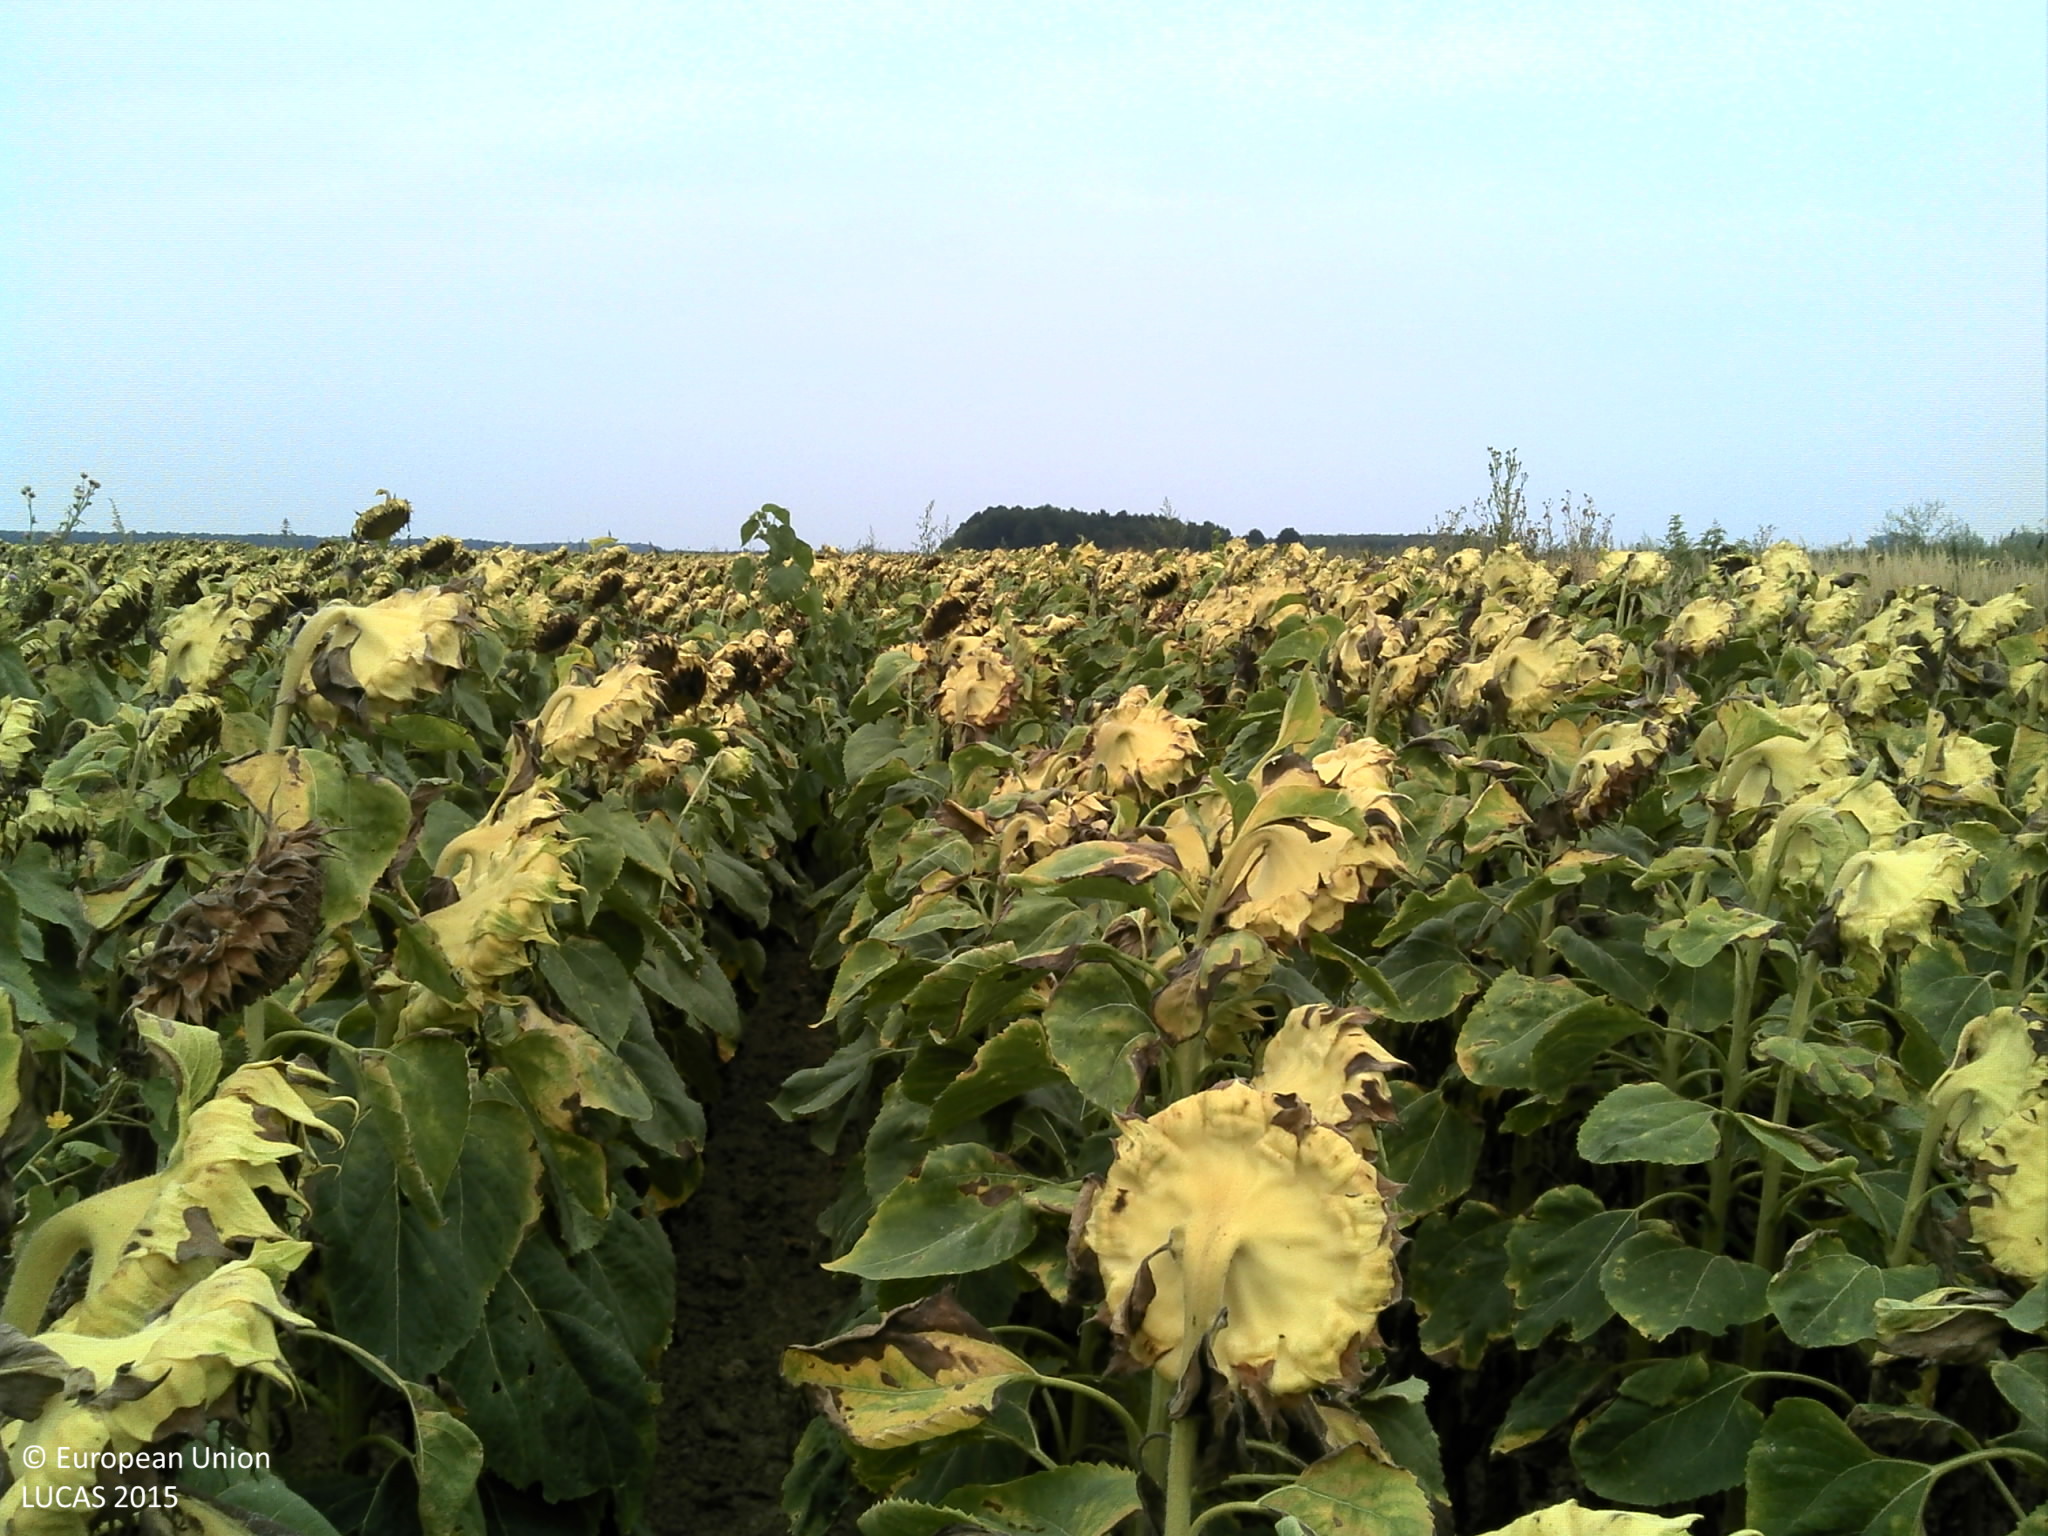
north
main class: Cropland
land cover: Sunflower
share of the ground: > 75 %
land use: Agriculture (excluding fallow land and kitchen gardens)
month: August
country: HR
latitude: 45.4681
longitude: 18.5119
